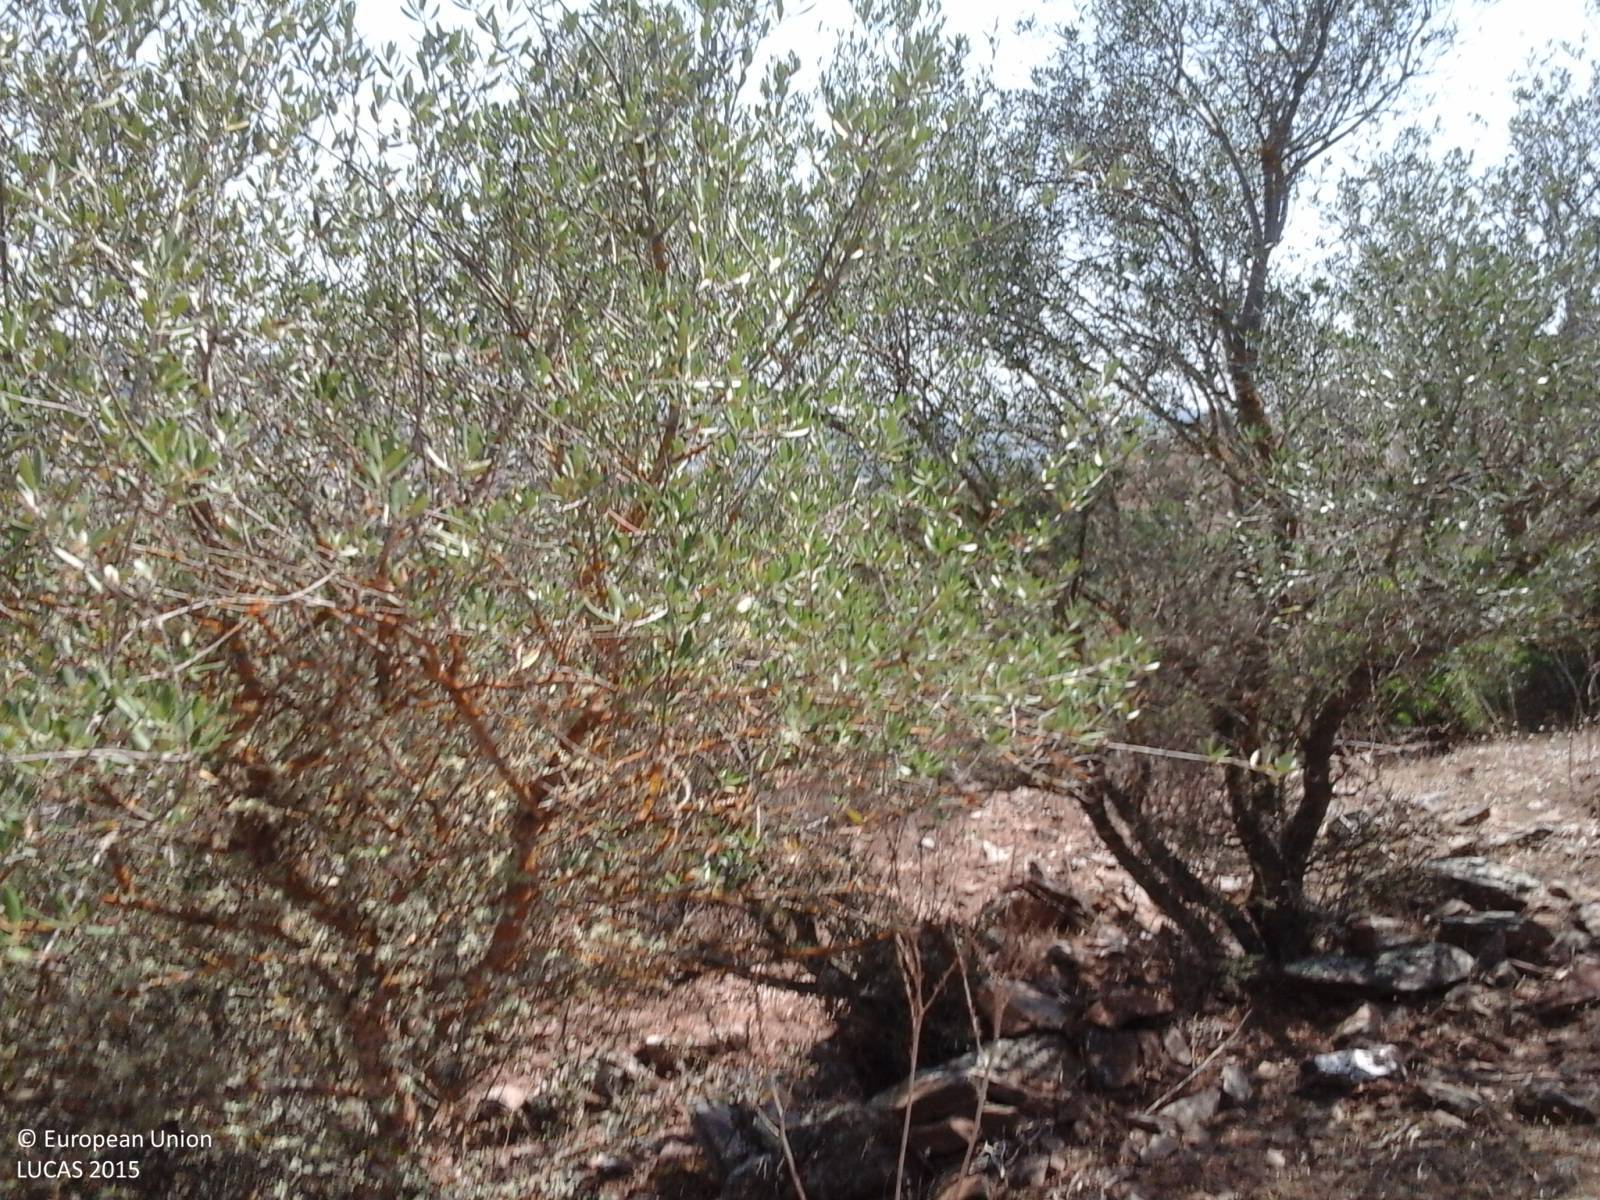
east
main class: Woodland
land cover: Broadleaved woodland
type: broadleaved evergreen forest
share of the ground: 50 - 75 %
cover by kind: broadleaved forest trees 100 %
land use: Forestry
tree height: < 5 m
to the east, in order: Broadleaved woodland; Fences; Grassland without tree/shrub cover; Fences; Tracks; Grassland without tree/shrub cover; Tracks; Electric lines; Tracks; Grass margins; Fences; Grassland without tree/shrub cover; Fences; Shrubland without tree cover; Tracks; Fences; Electric lines; Grassland without tree/shrub cover
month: July
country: IT
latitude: 39.9528
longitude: 8.8475
